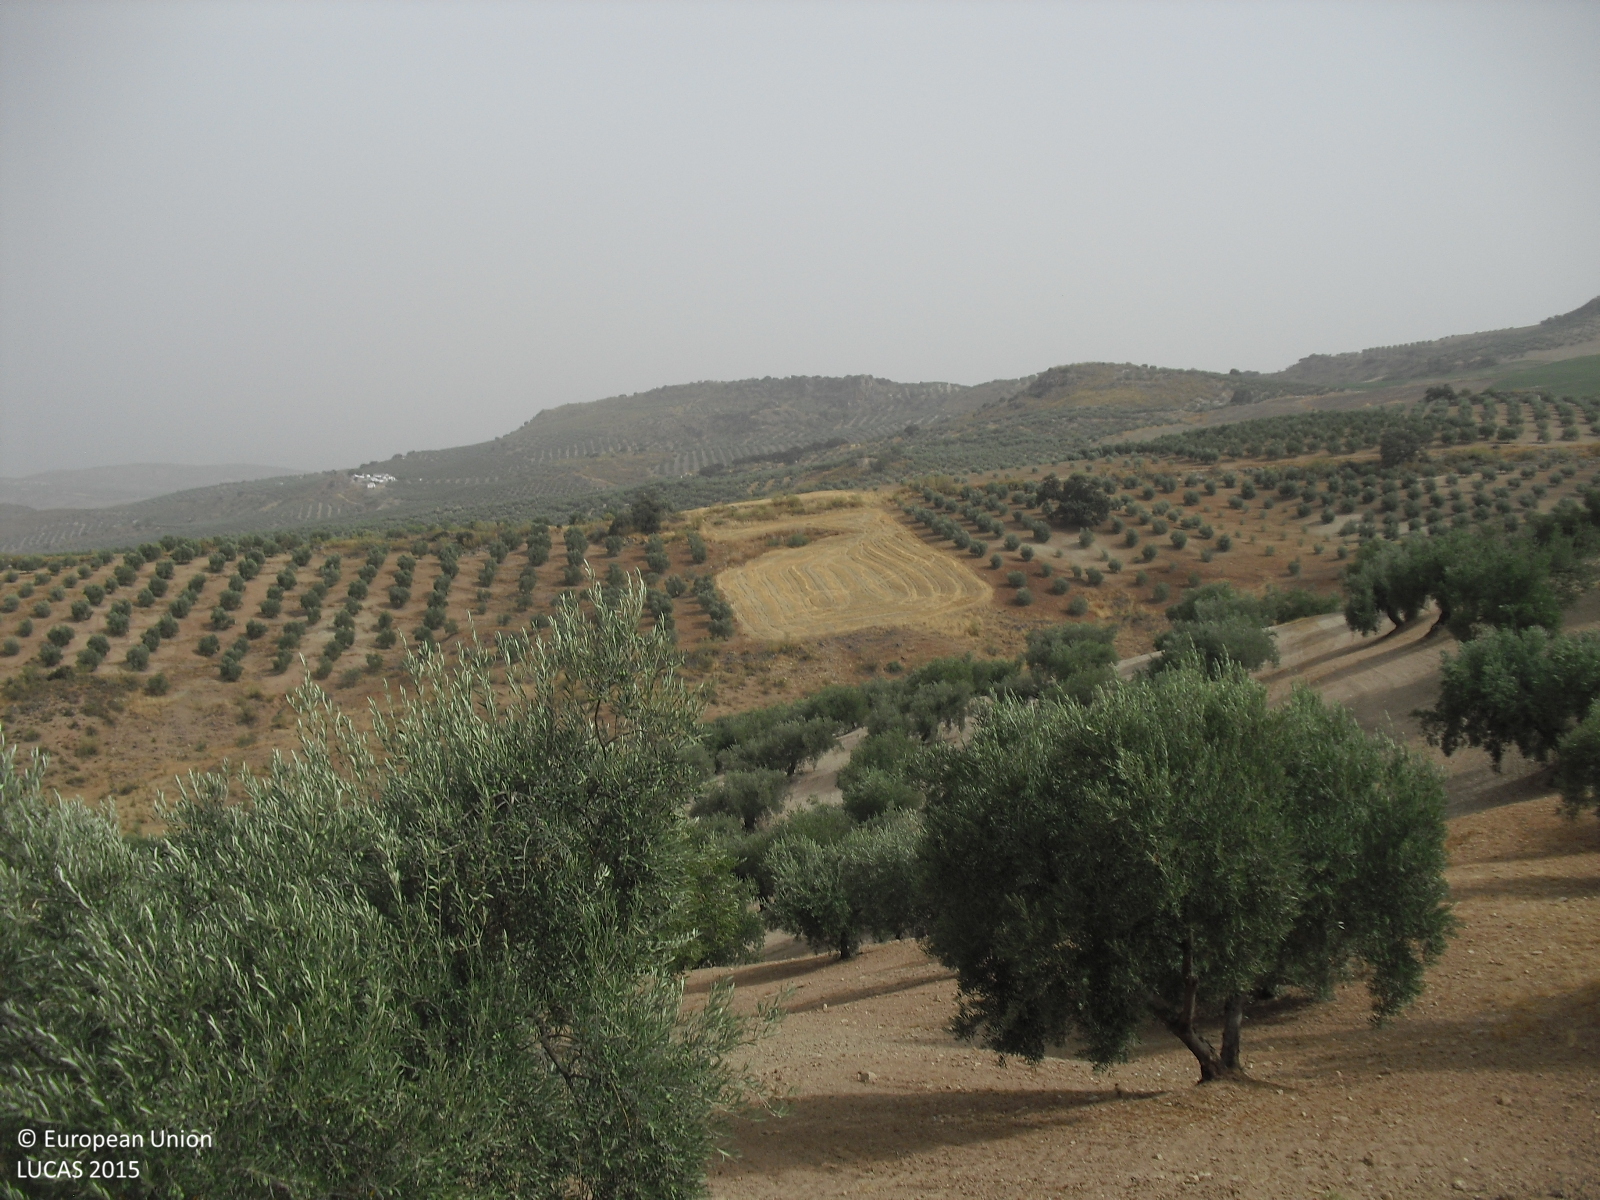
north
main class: Cropland
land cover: Olive groves
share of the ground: 10 - 25 %
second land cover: Spontaneously vegetated surfaces
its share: 10 - 25 %
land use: Agriculture (excluding fallow land and kitchen gardens)
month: August
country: ES
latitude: 37.2117
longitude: -4.1826
